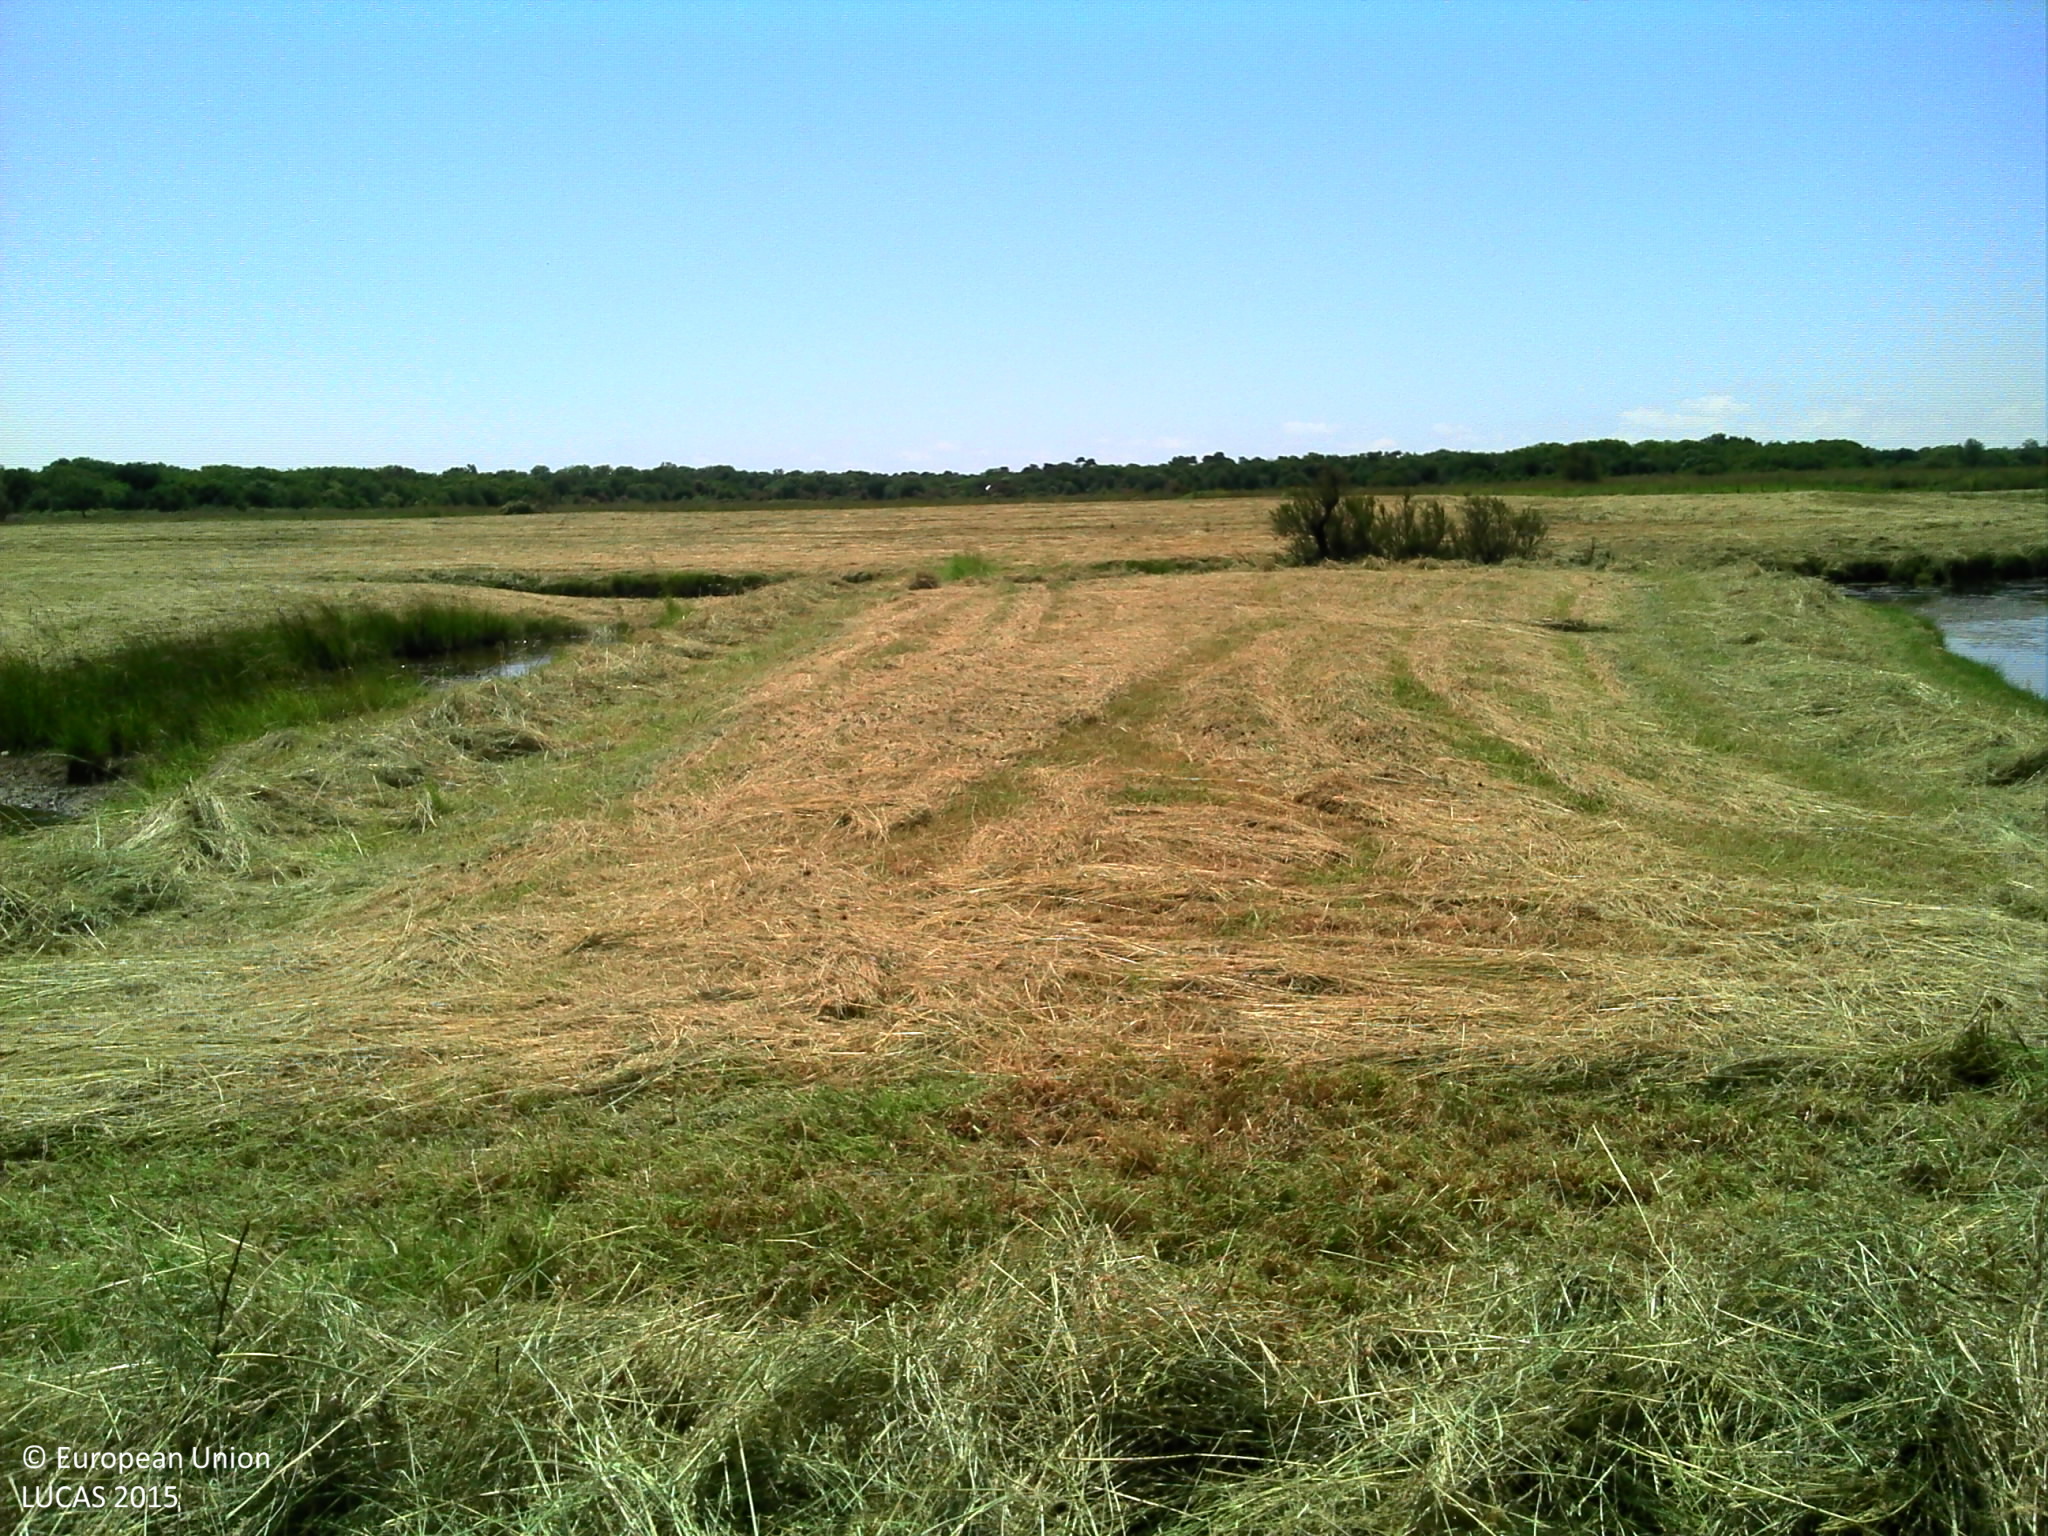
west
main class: Grassland
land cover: Grassland without tree/shrub cover
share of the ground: > 75 %
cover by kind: herbaceous plants 100 %
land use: Agriculture (excluding fallow land and kitchen gardens)
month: May
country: FR
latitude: 45.9358
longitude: -1.2657
